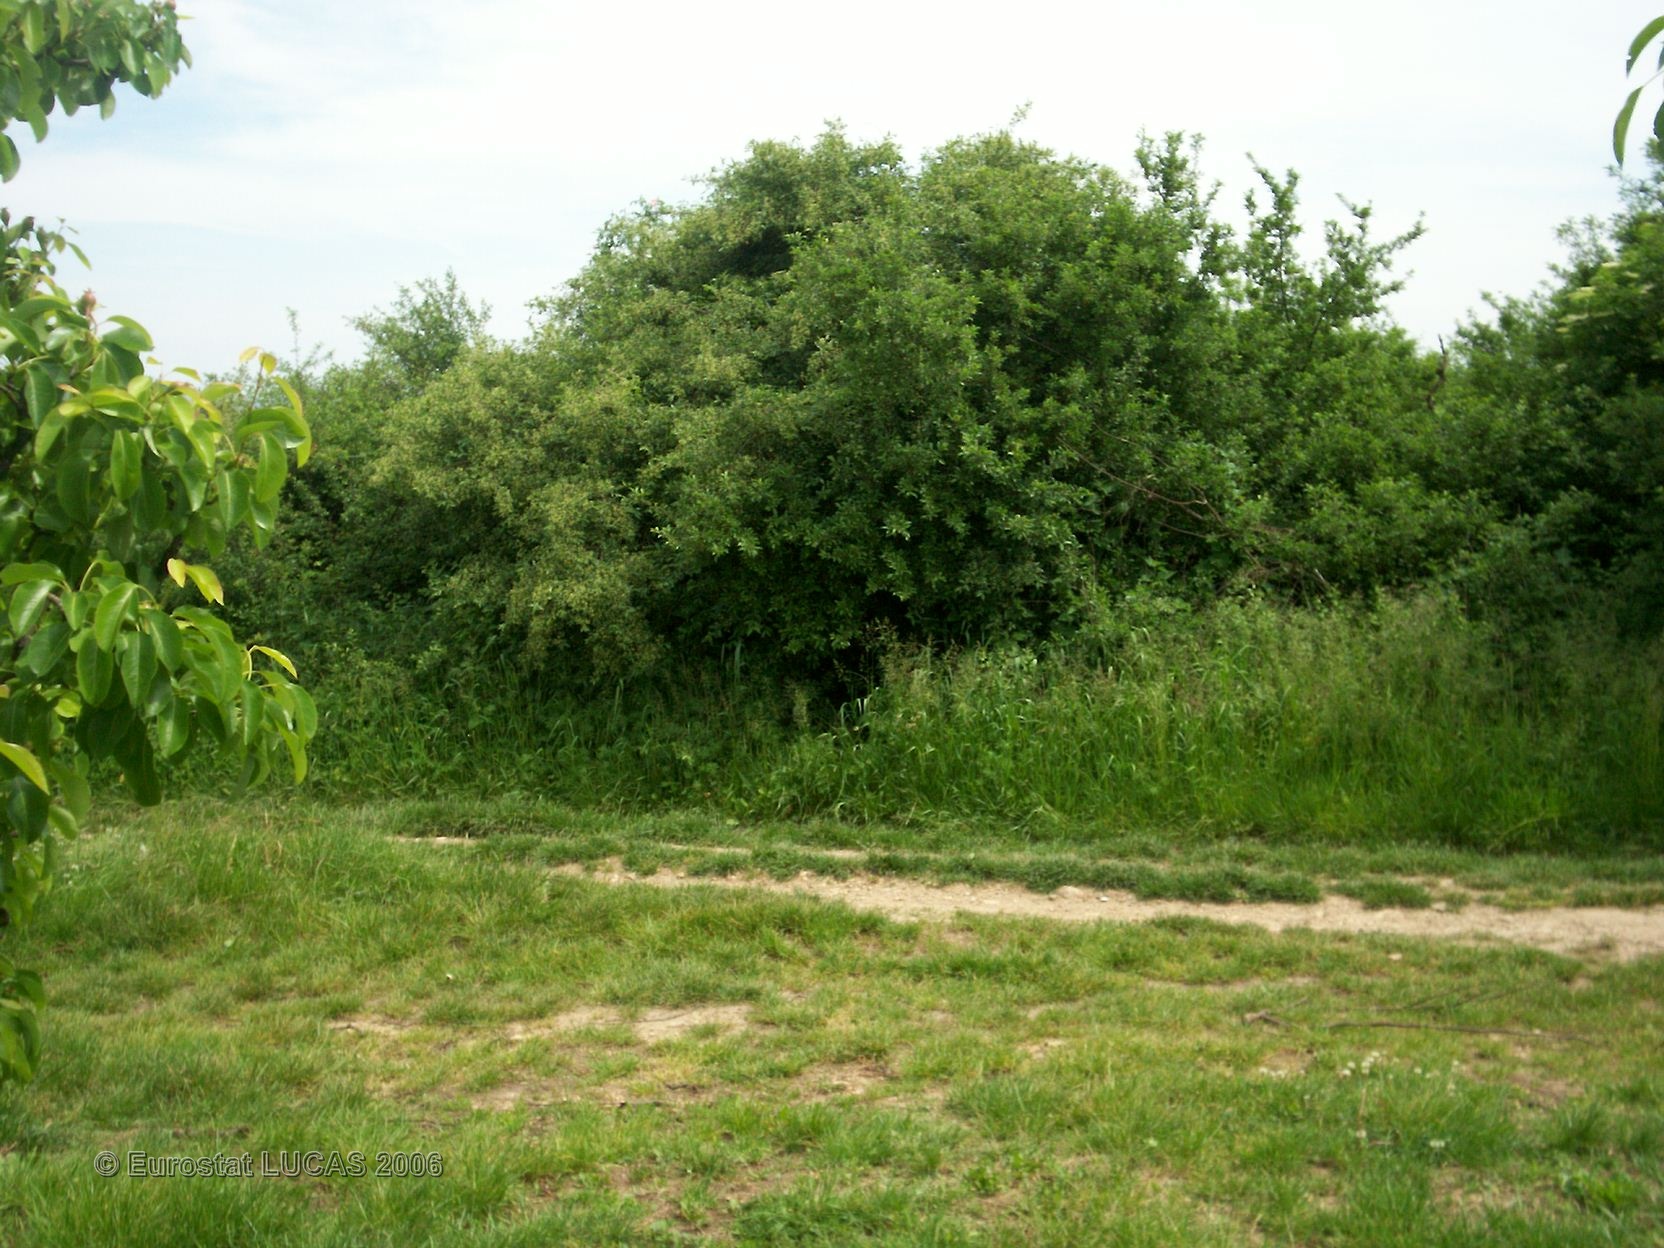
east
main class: Cropland
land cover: Pear fruit
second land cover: Grassland with sparse tree/shrub cover
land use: Agriculture (excluding fallow land and kitchen gardens)
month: May
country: FR
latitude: 45.6654
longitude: 4.8055
